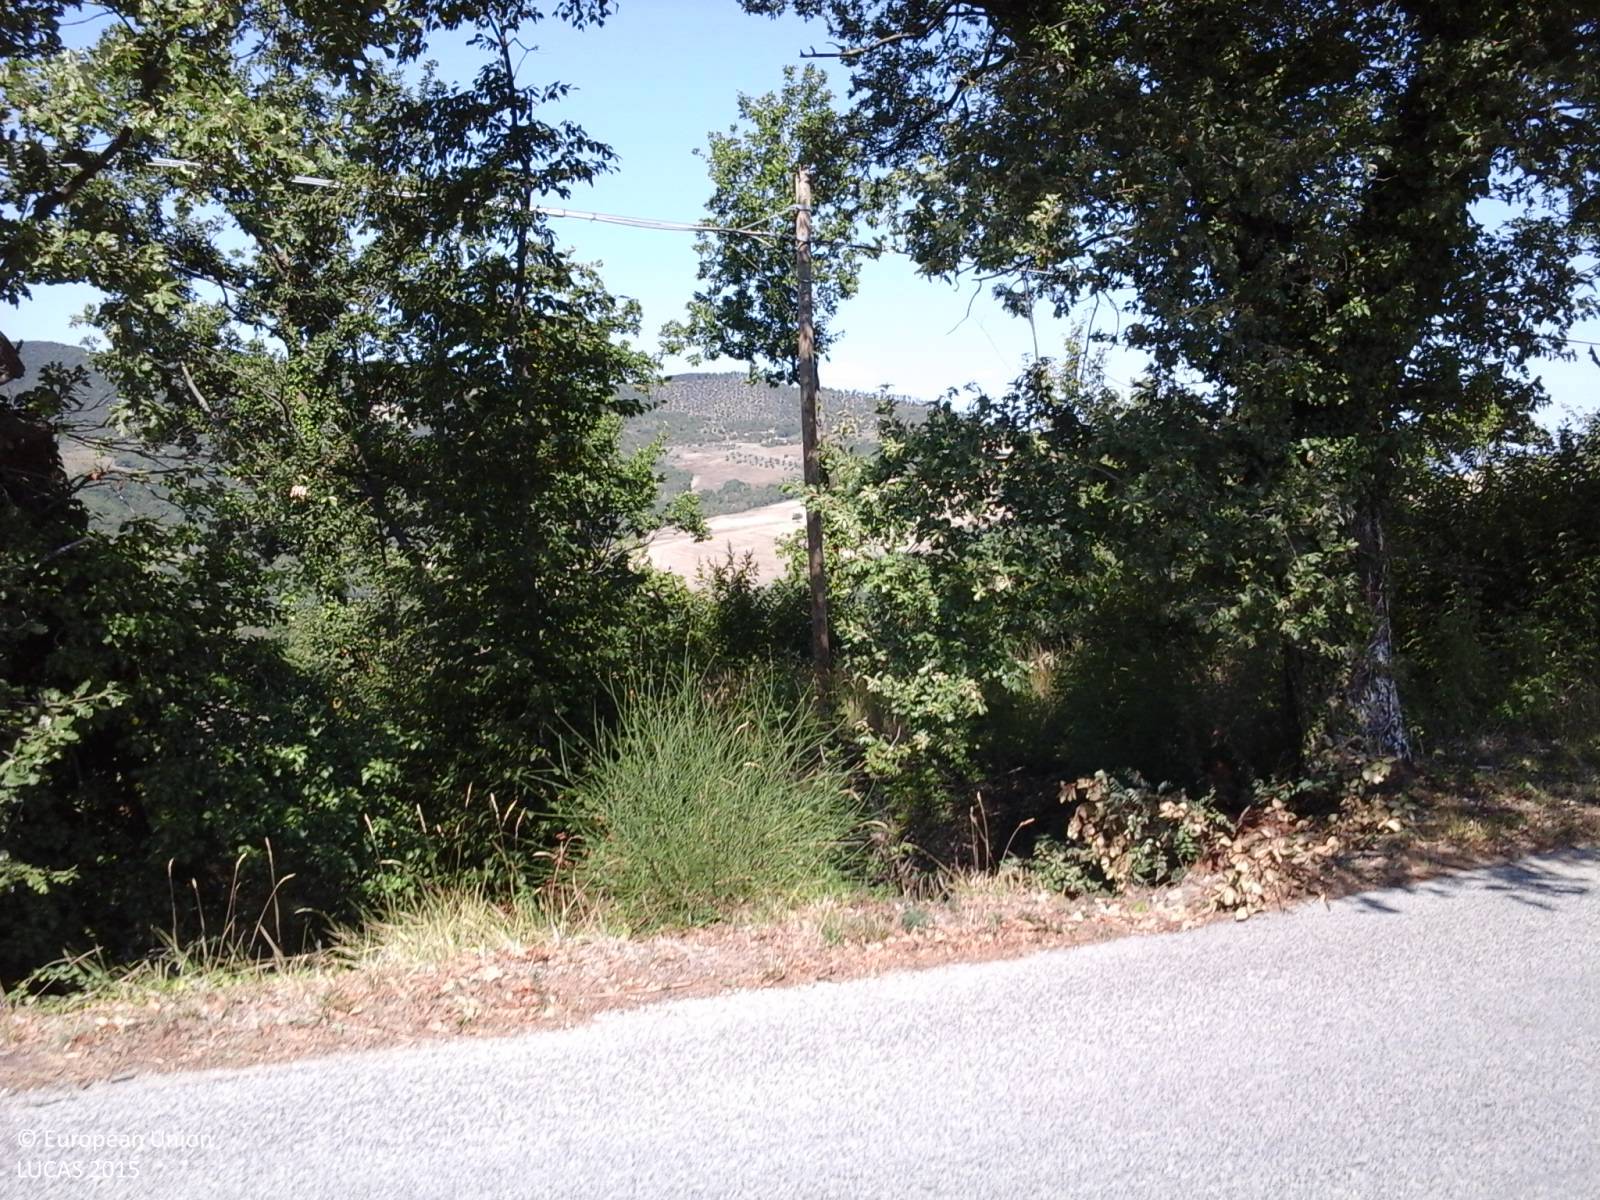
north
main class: Grassland
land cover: Grassland without tree/shrub cover
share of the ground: > 75 %
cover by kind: herbaceous plants 100 %
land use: Agriculture (excluding fallow land and kitchen gardens)
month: September
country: IT
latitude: 43.1082
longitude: 12.6099
